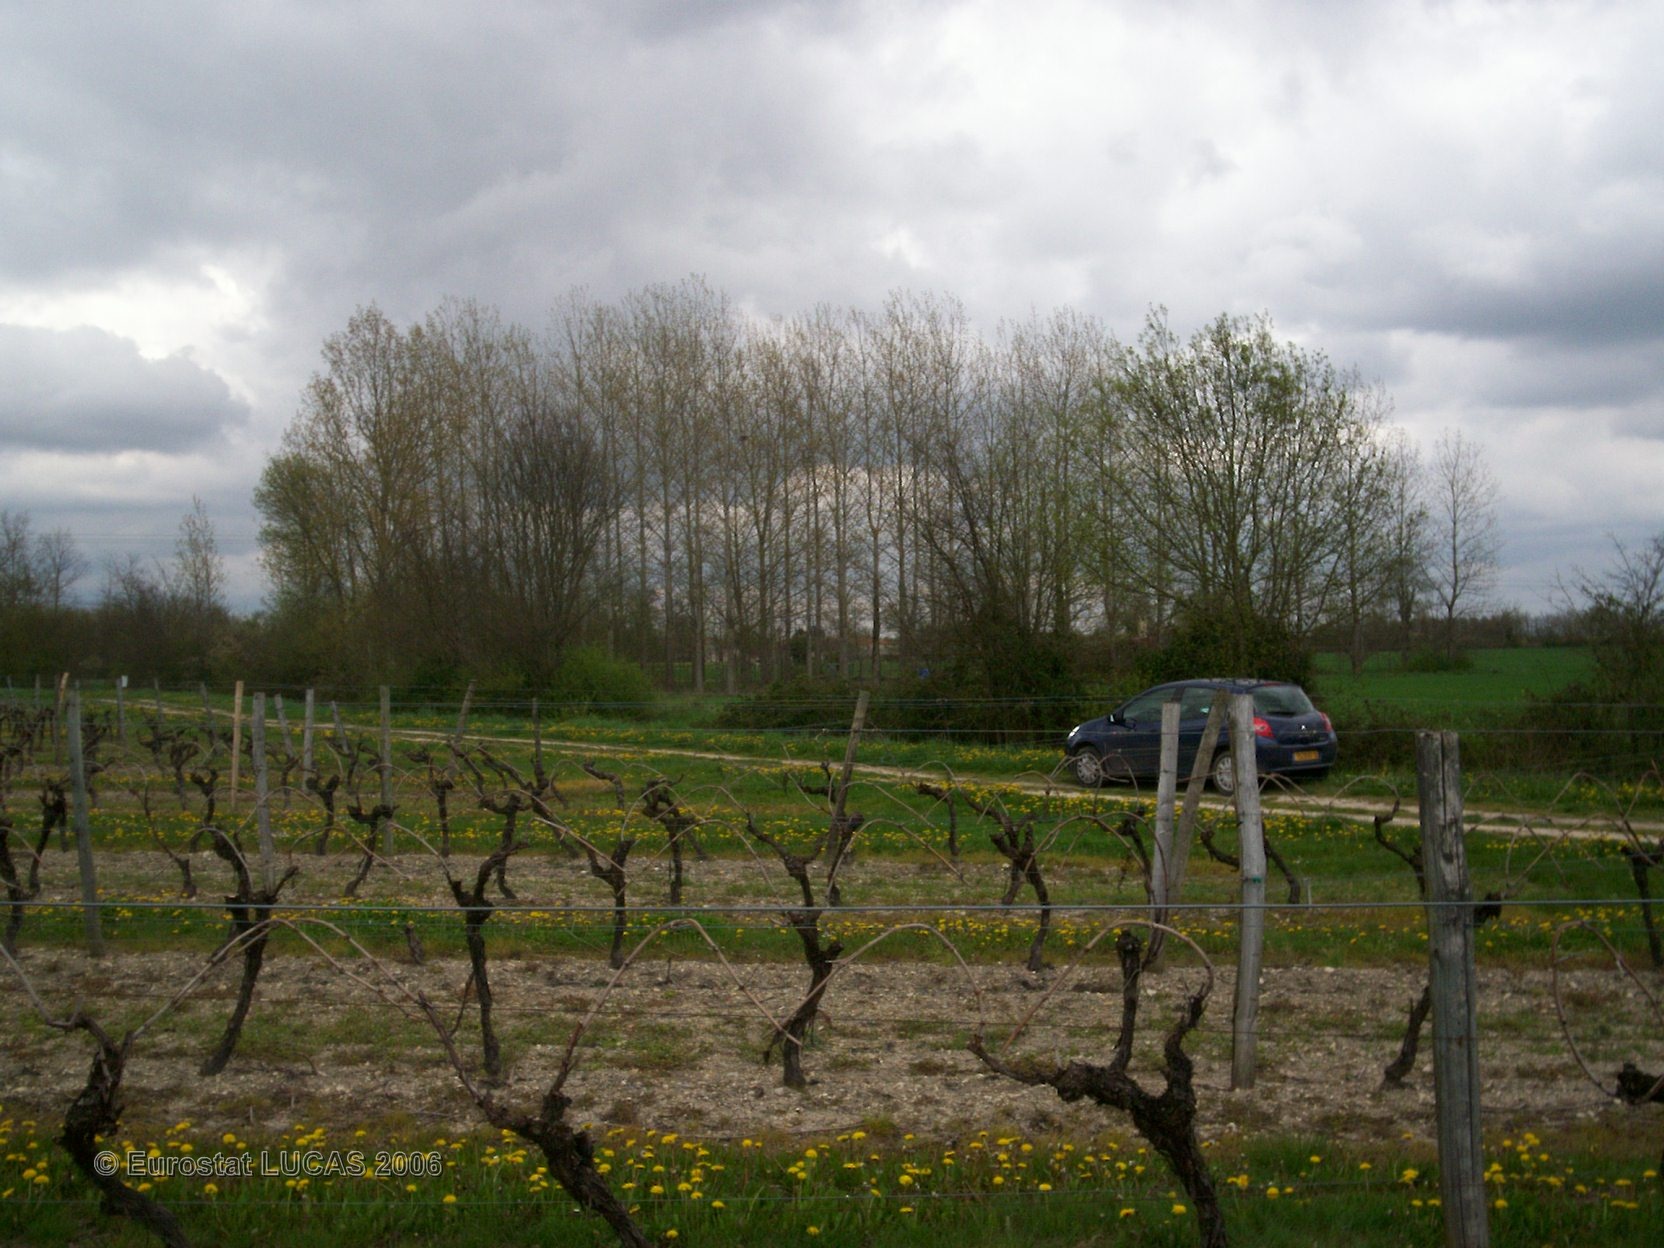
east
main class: Cropland
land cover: Vineyards
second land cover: Grassland with sparse tree/shrub cover
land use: Agriculture (excluding fallow land and kitchen gardens)
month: April
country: FR
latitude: 45.7011
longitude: -0.1787
